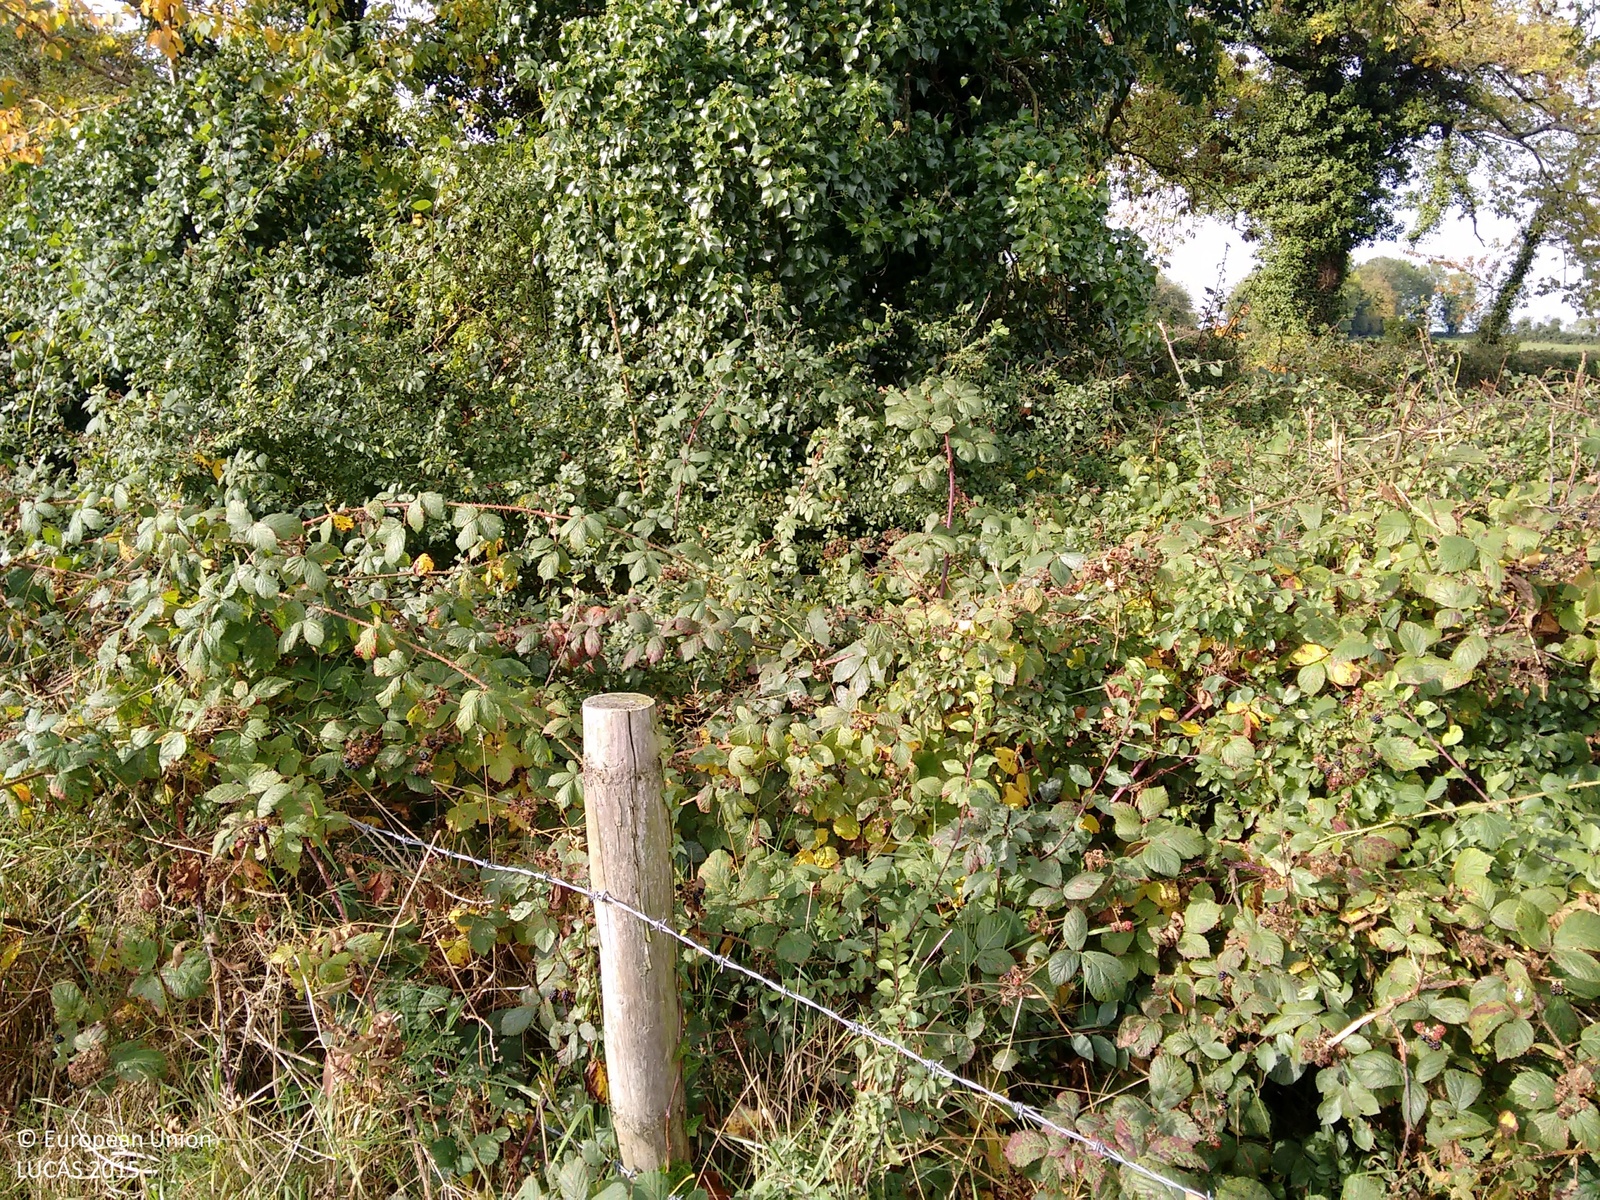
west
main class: Grassland
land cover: Grassland without tree/shrub cover
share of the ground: > 75 %
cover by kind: herbaceous plants 100 %
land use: Agriculture (excluding fallow land and kitchen gardens)
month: October
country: GB
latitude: 54.1403
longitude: -7.4998
